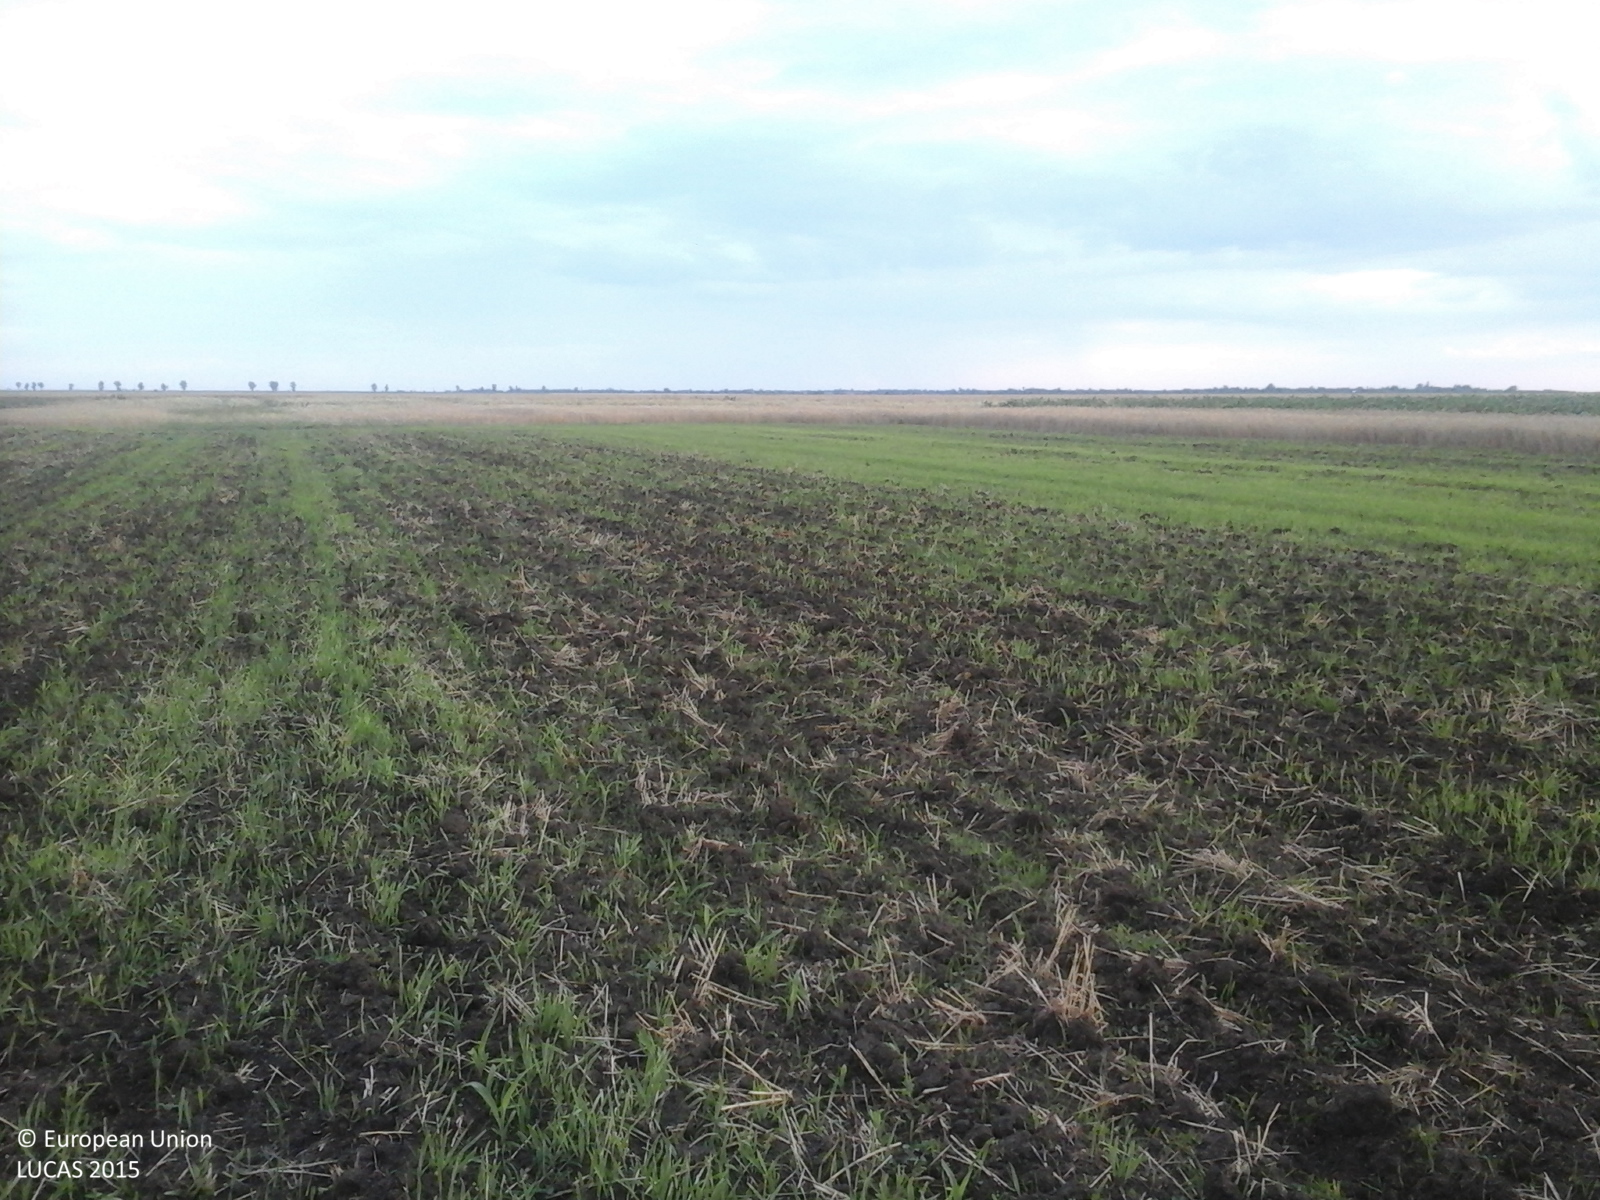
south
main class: Cropland
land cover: Maize
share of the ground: < 10 %
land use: Agriculture (excluding fallow land and kitchen gardens)
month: July
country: RO
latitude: 44.3705
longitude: 24.8728
